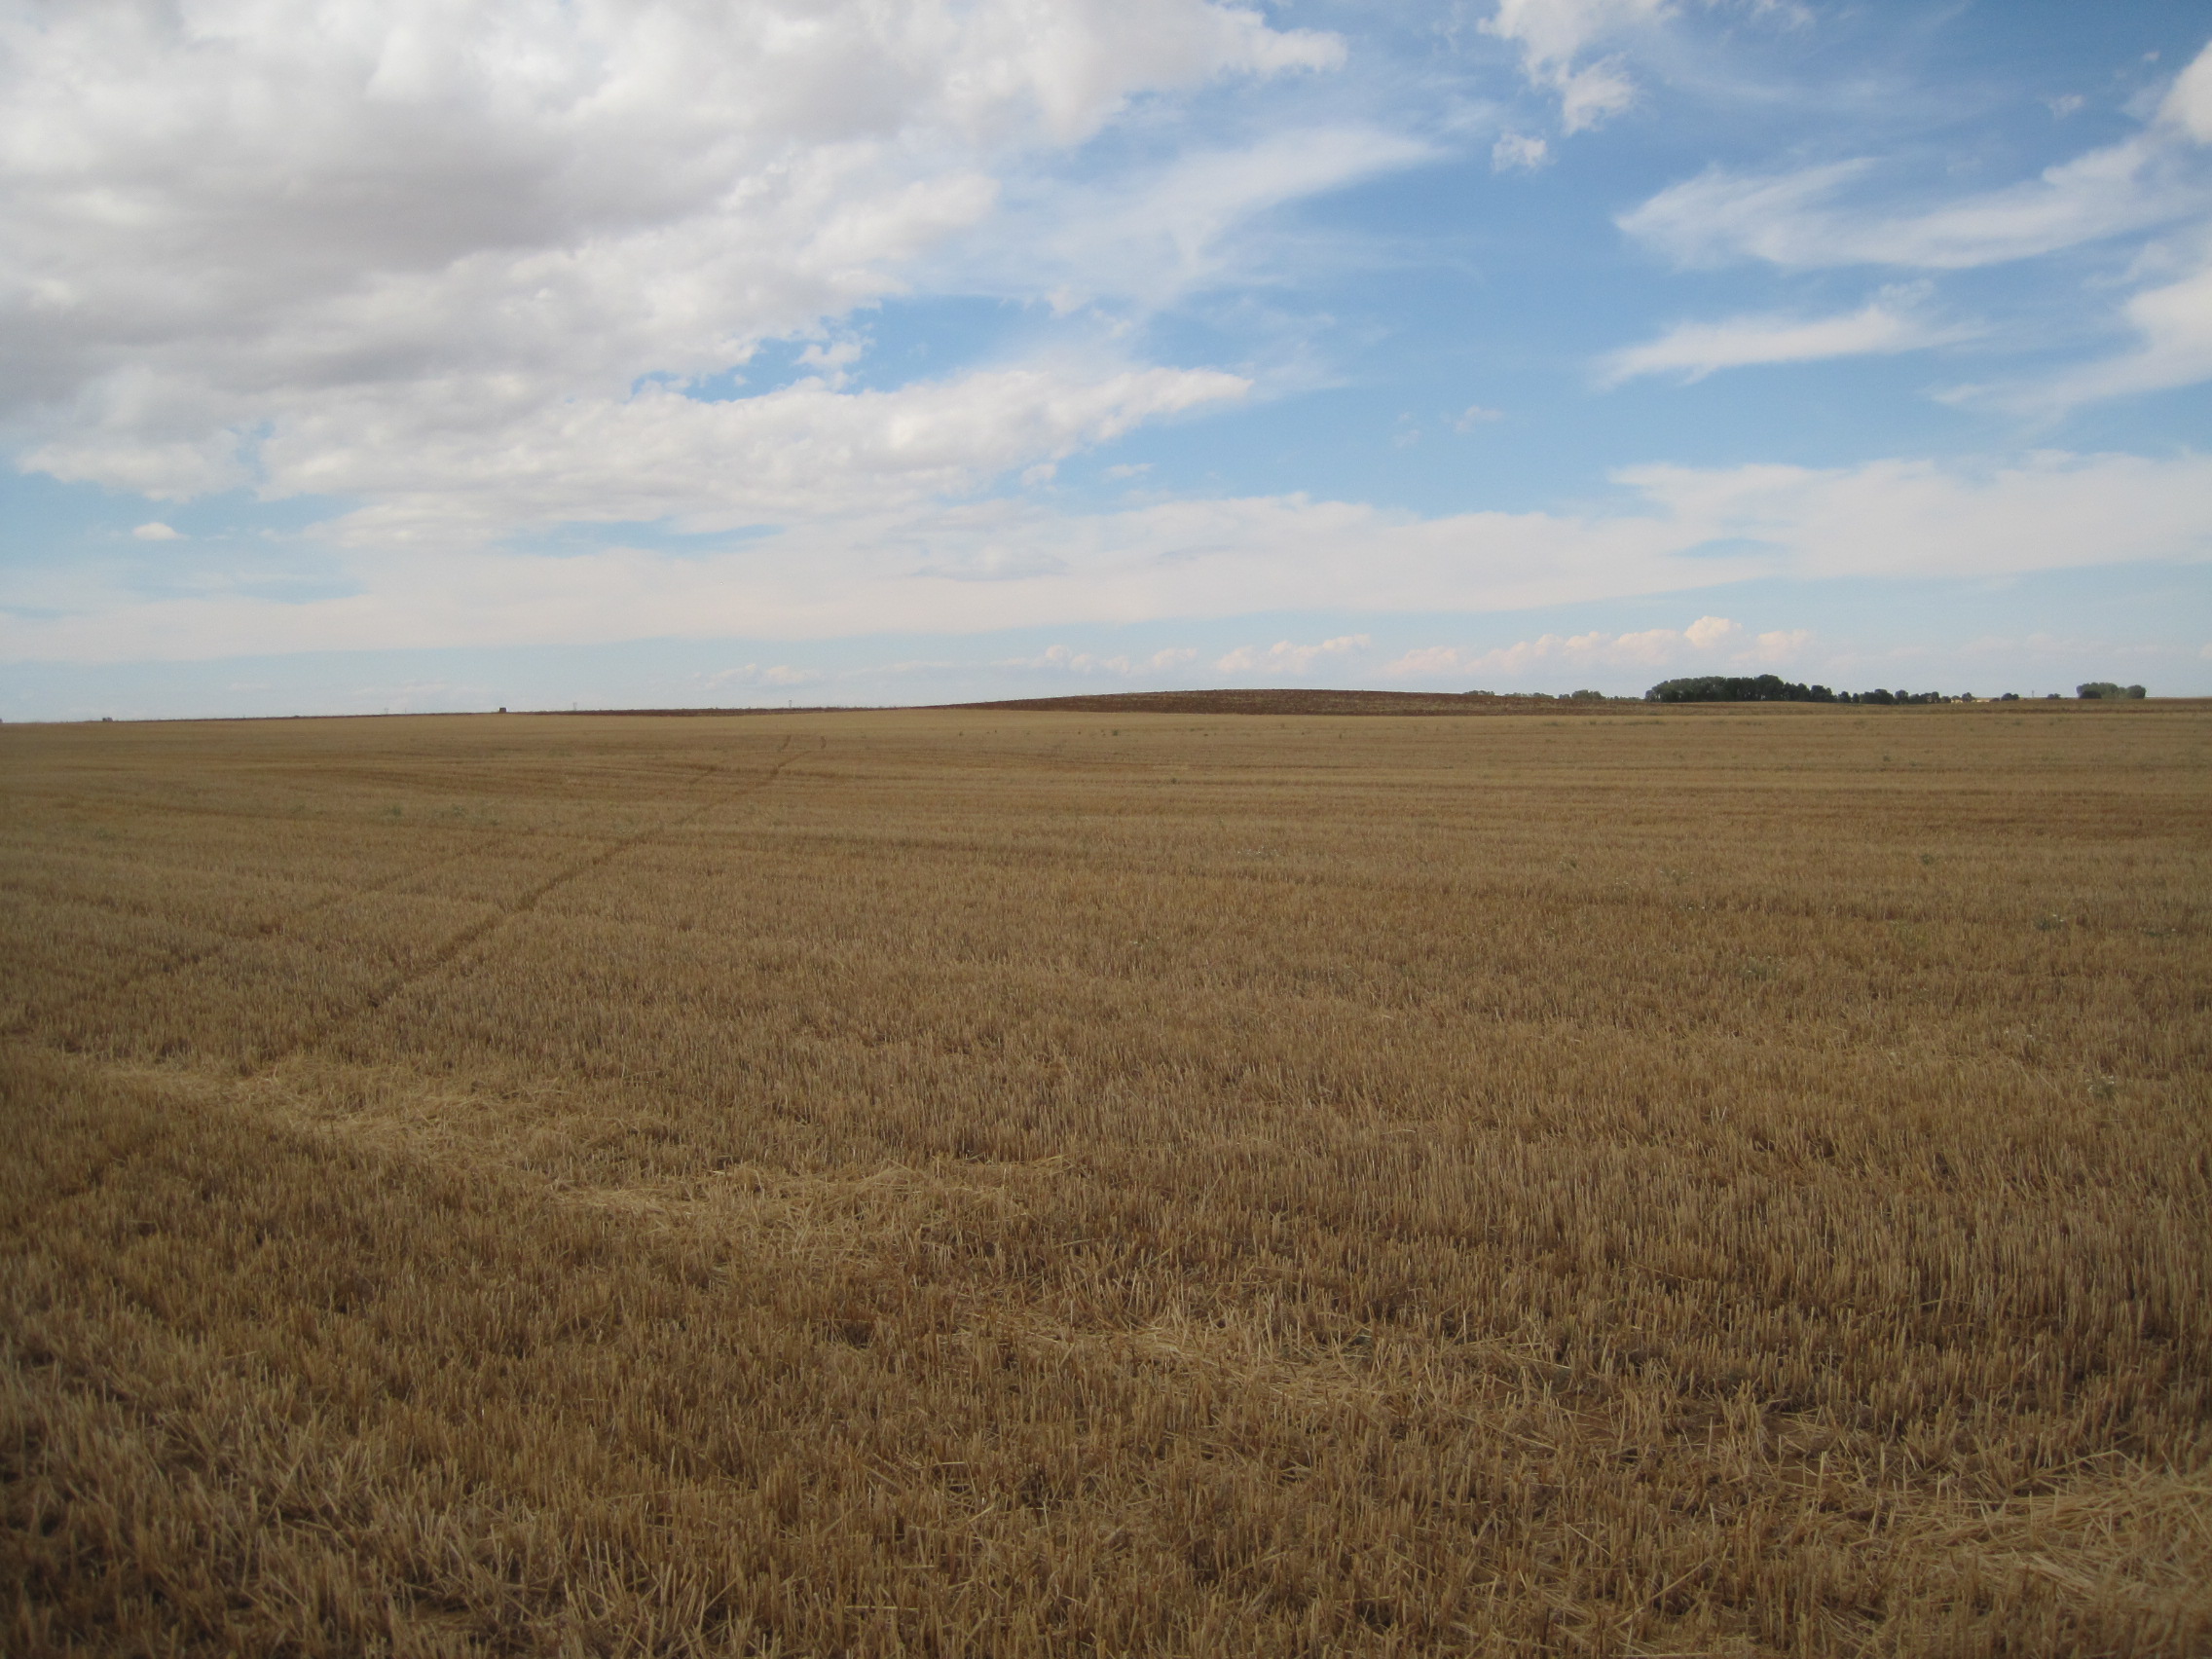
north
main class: Cropland
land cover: Barley
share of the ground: < 10 %
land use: Agriculture (excluding fallow land and kitchen gardens)
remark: Harvested field
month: July
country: ES
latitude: 41.8890
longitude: -5.5256
